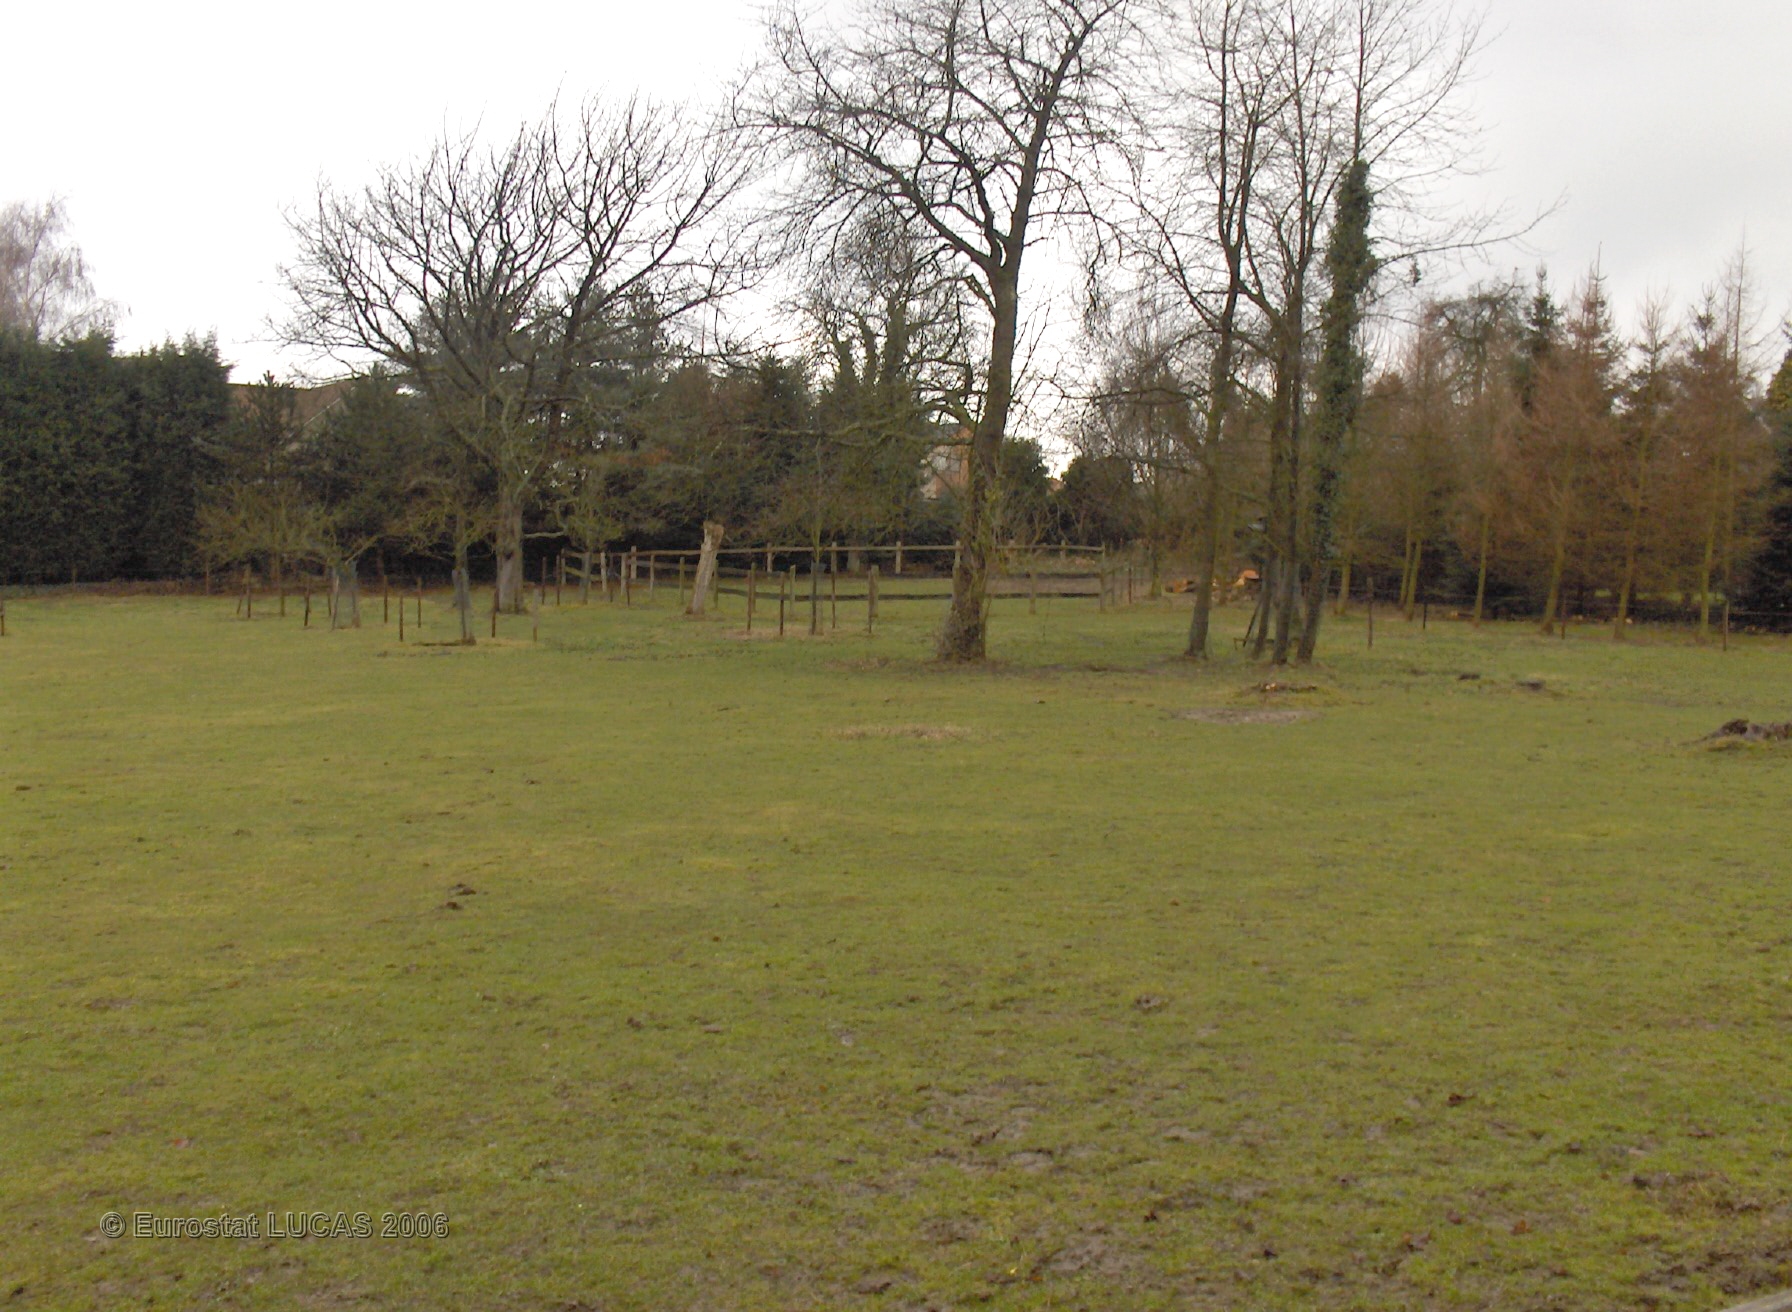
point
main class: Grassland
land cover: Grassland with sparse tree/shrub cover
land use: Agriculture (excluding fallow land and kitchen gardens)
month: February
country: BE
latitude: 50.7715
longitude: 4.4797
